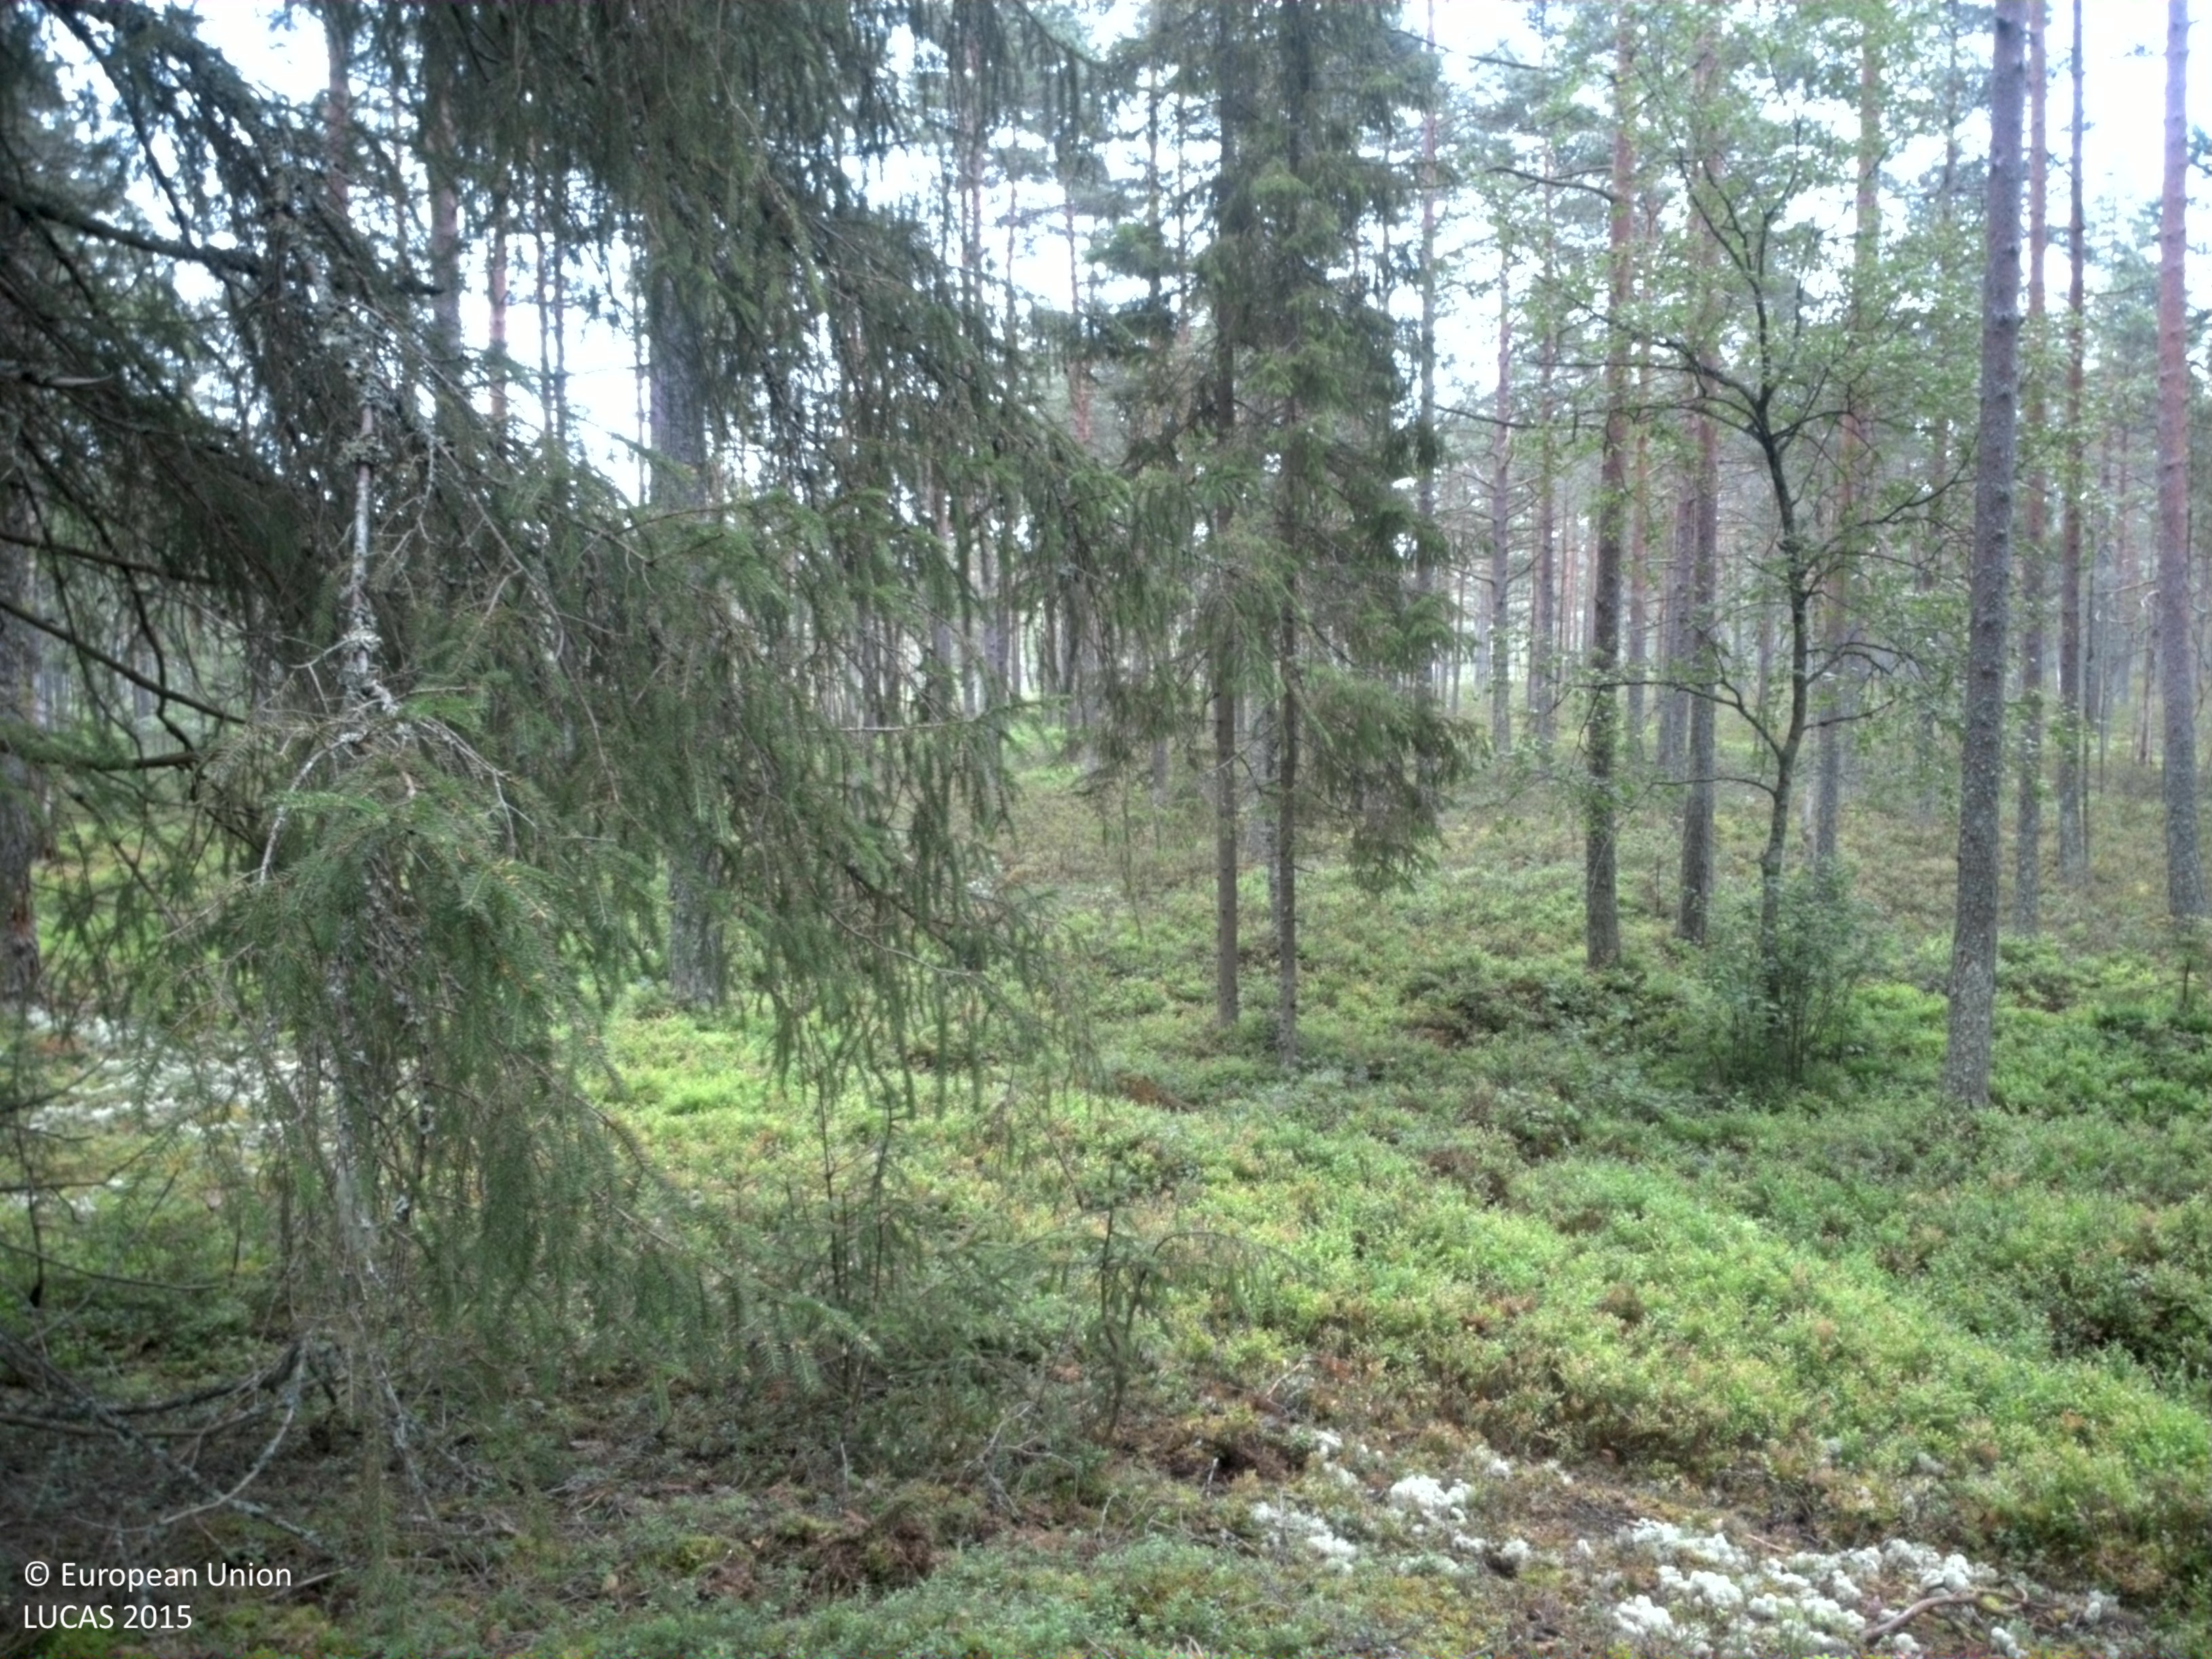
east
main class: Woodland
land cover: Spruce dominated coniferous woodland
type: boreal forest
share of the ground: 50 - 75 %
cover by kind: coniferous forest trees 65 %, shrubs 20 %, lichens and mosses 10 %, broadleaved forest trees 5 %
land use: Forestry
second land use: Amenities, museums, leisure
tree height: > 5 m
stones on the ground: 25 - 50 %
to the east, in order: Spruce dominated coniferous woodland; Pine dominated coniferous woodland; Pine dominated mixed woodland; Rivers and streams; Pine dominated mixed woodland; Pine dominated coniferous woodland; Pine dominated mixed woodland; Rivers and streams; Pine dominated mixed woodland
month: July
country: SE
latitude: 59.4030
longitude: 13.3213
